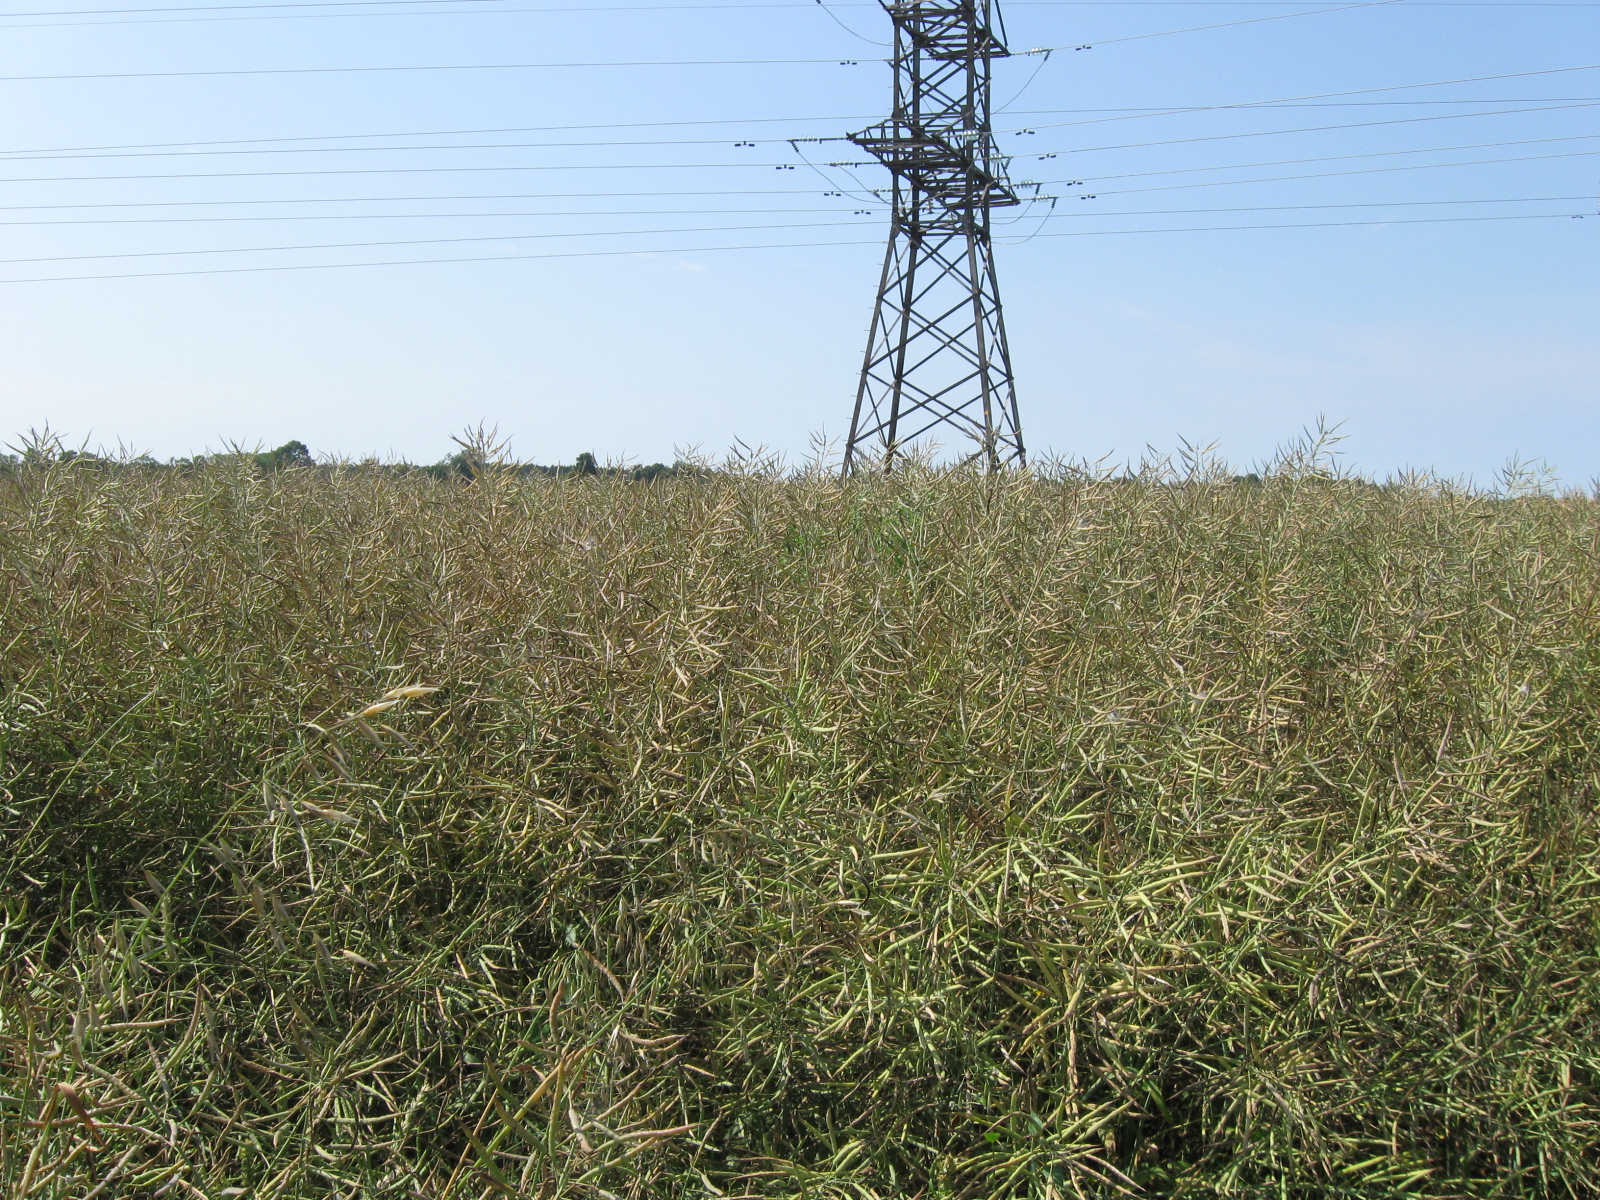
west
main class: Cropland
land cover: Rape and turnip rape
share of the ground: > 75 %
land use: Agriculture (excluding fallow land and kitchen gardens)
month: July
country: LT
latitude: 54.6727
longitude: 23.9380
